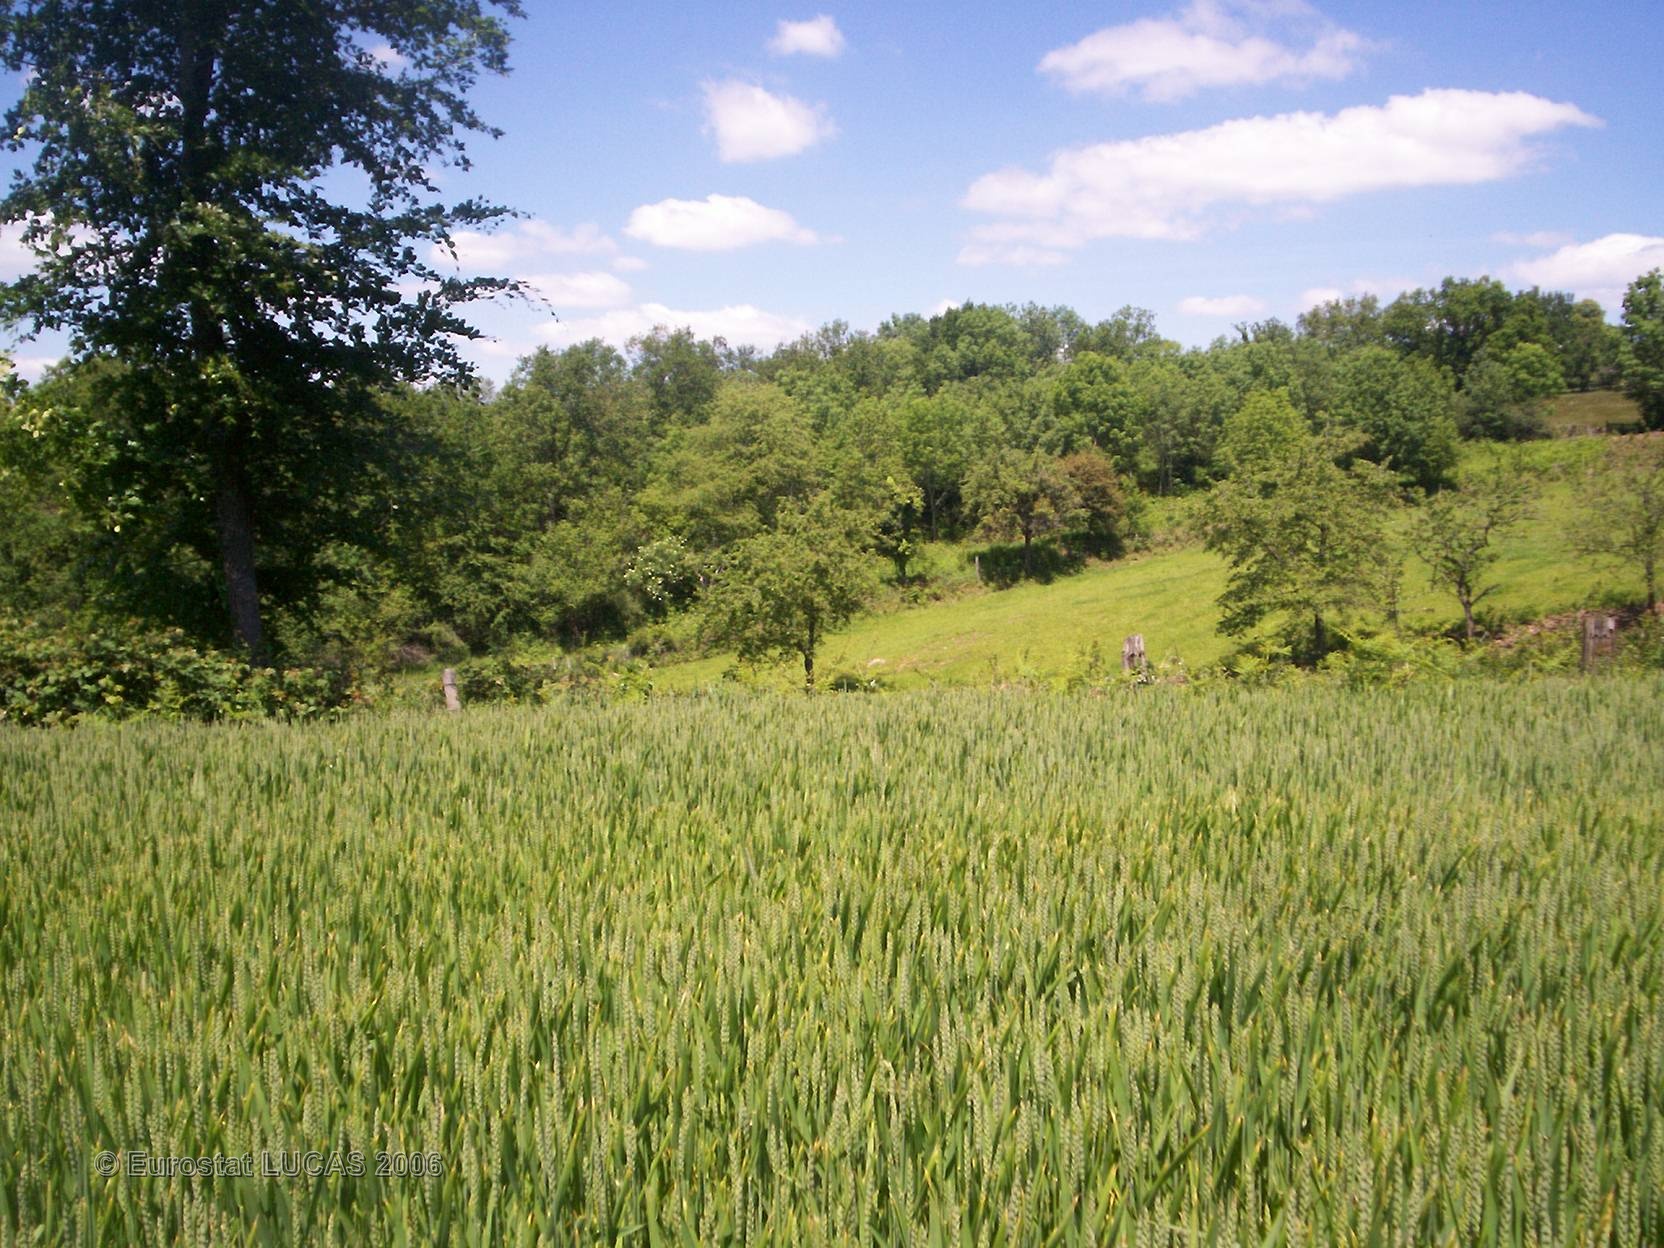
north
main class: Cropland
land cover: Common wheat
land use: Agriculture (excluding fallow land and kitchen gardens)
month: June
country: FR
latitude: 46.2581
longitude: 2.8753
